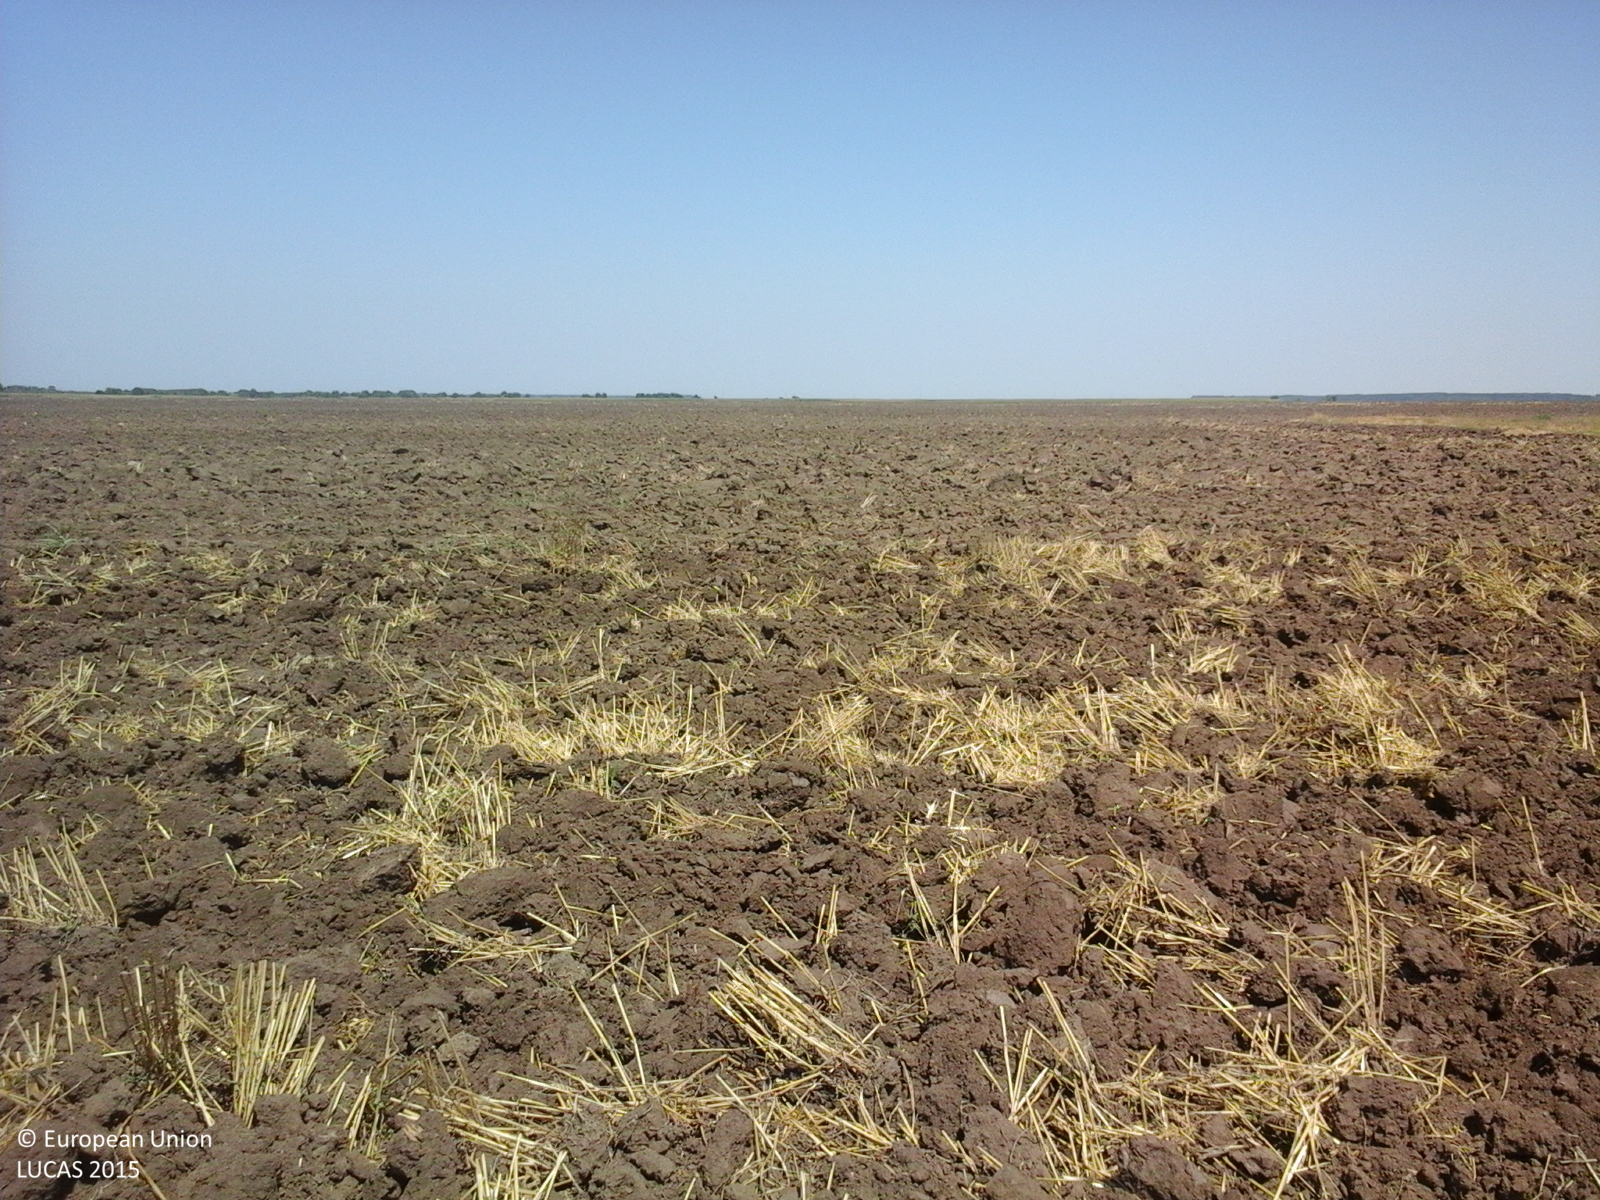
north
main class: Cropland
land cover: Durum wheat
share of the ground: < 10 %
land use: Agriculture (excluding fallow land and kitchen gardens)
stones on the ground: < 10 %
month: July
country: RO
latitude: 44.3446
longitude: 26.4831
